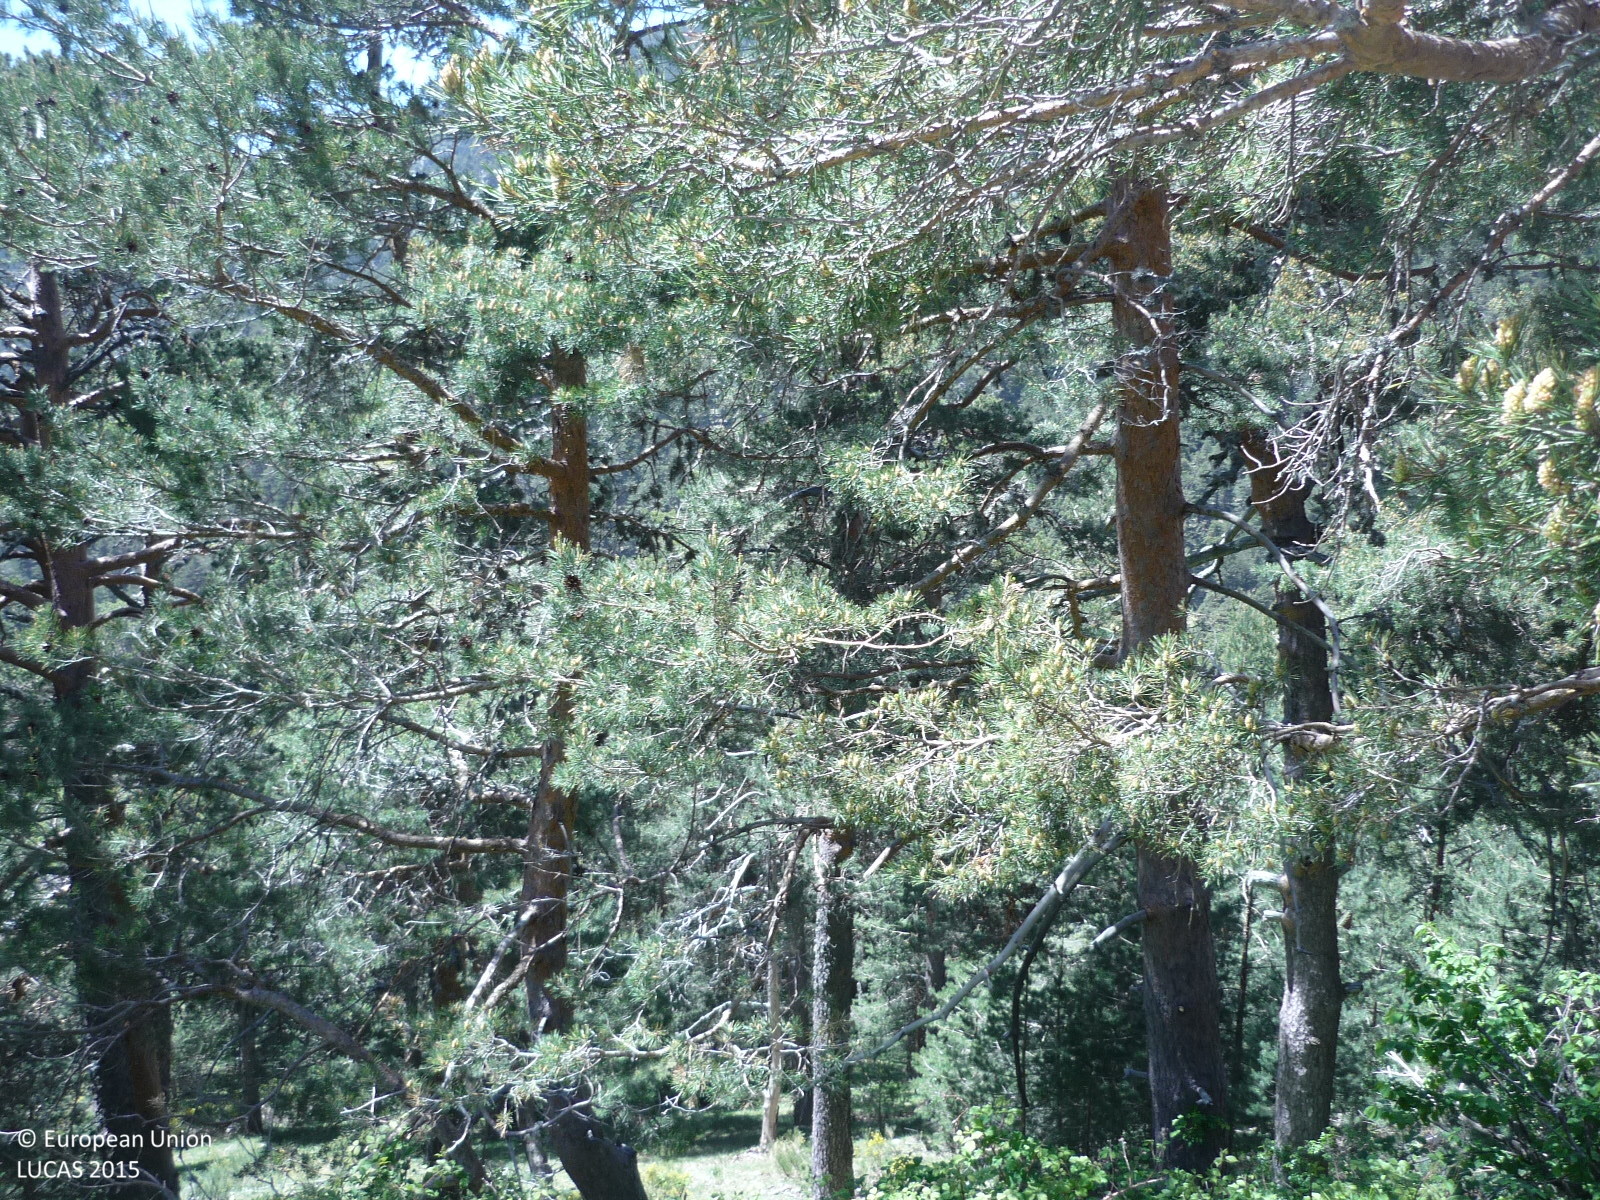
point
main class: Woodland
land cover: Pine dominated coniferous woodland
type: coniferous forest of the mediterranean region
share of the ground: > 75 %
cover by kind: coniferous forest trees 85 %, shrubs 10 %, herbaceous plants 5 %
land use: Forestry
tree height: > 5 m
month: May
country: ES
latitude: 40.7768
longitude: -4.0161
